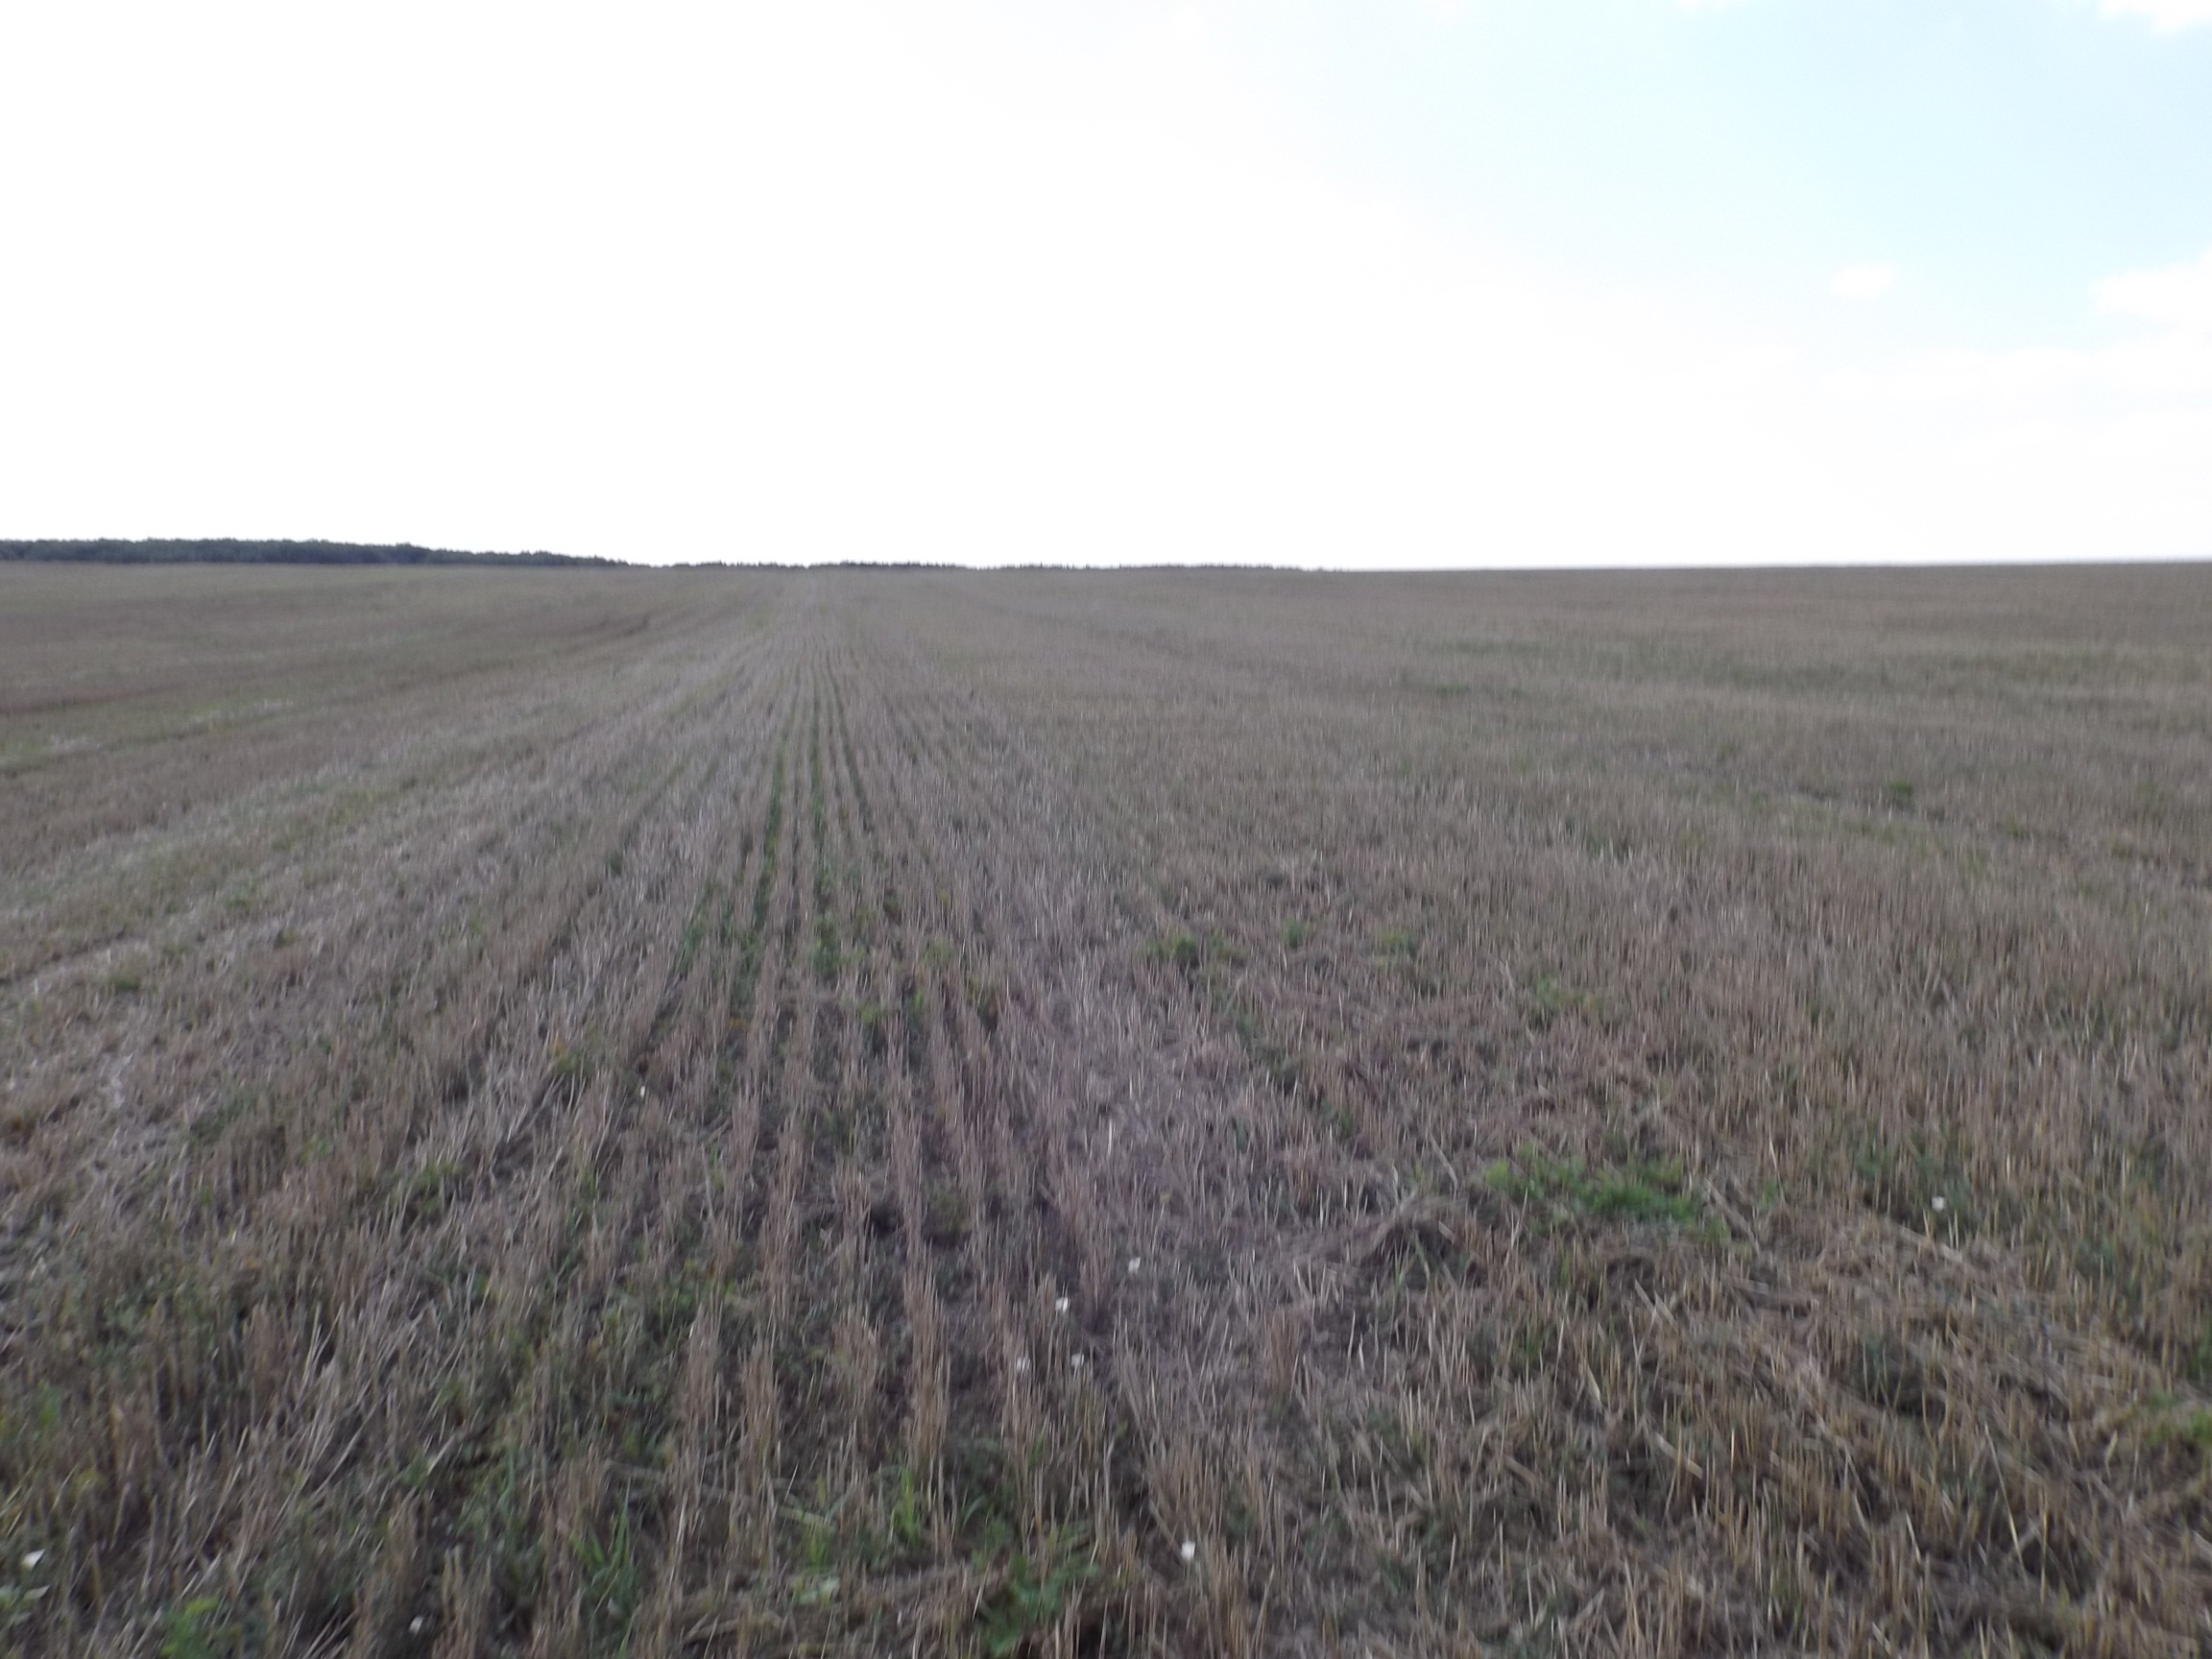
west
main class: Cropland
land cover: Common wheat
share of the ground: < 10 %
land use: Agriculture (excluding fallow land and kitchen gardens)
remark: Harvested field
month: August
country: BG
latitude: 43.4273
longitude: 27.4598
